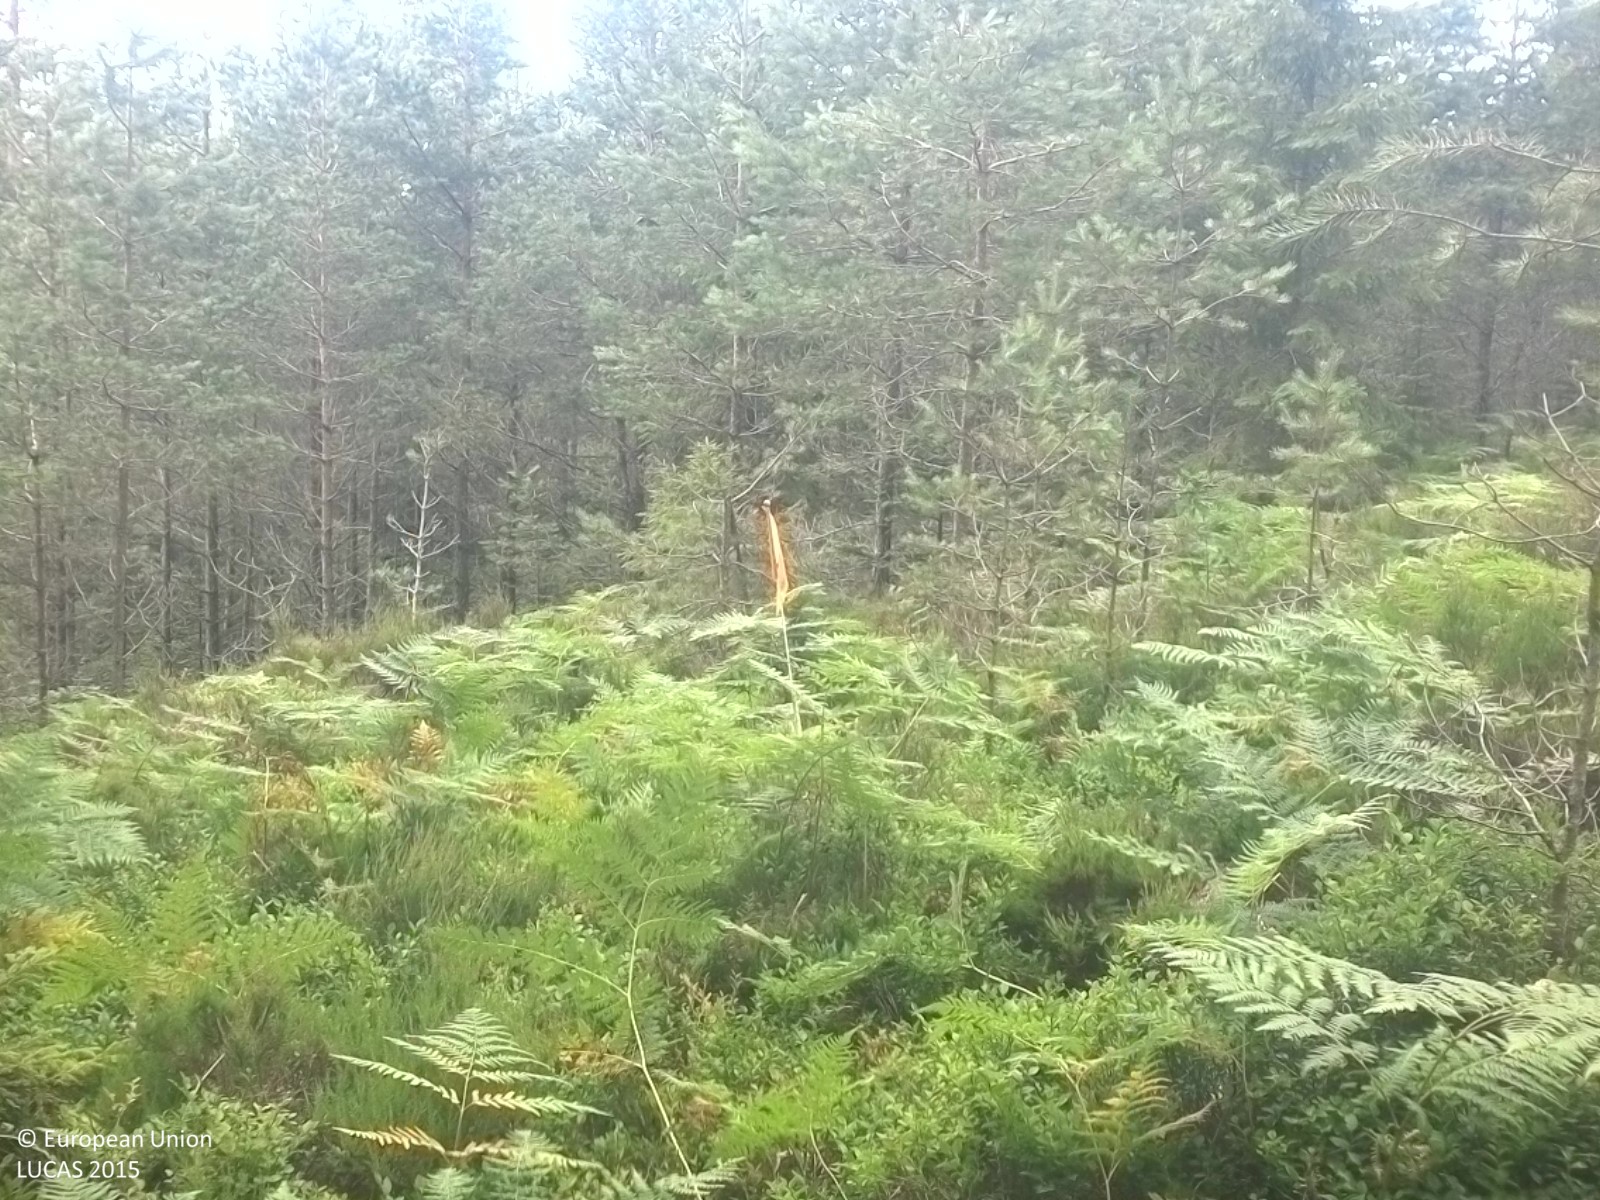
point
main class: Woodland
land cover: Other coniferous woodland
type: boreal forest
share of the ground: 10 - 25 %
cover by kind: herbaceous plants 50 %, coniferous forest trees 20 %, shrubs 20 %, lichens and mosses 10 %
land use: Forestry
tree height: < 5 m
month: July
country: SE
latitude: 58.9860
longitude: 15.1603
